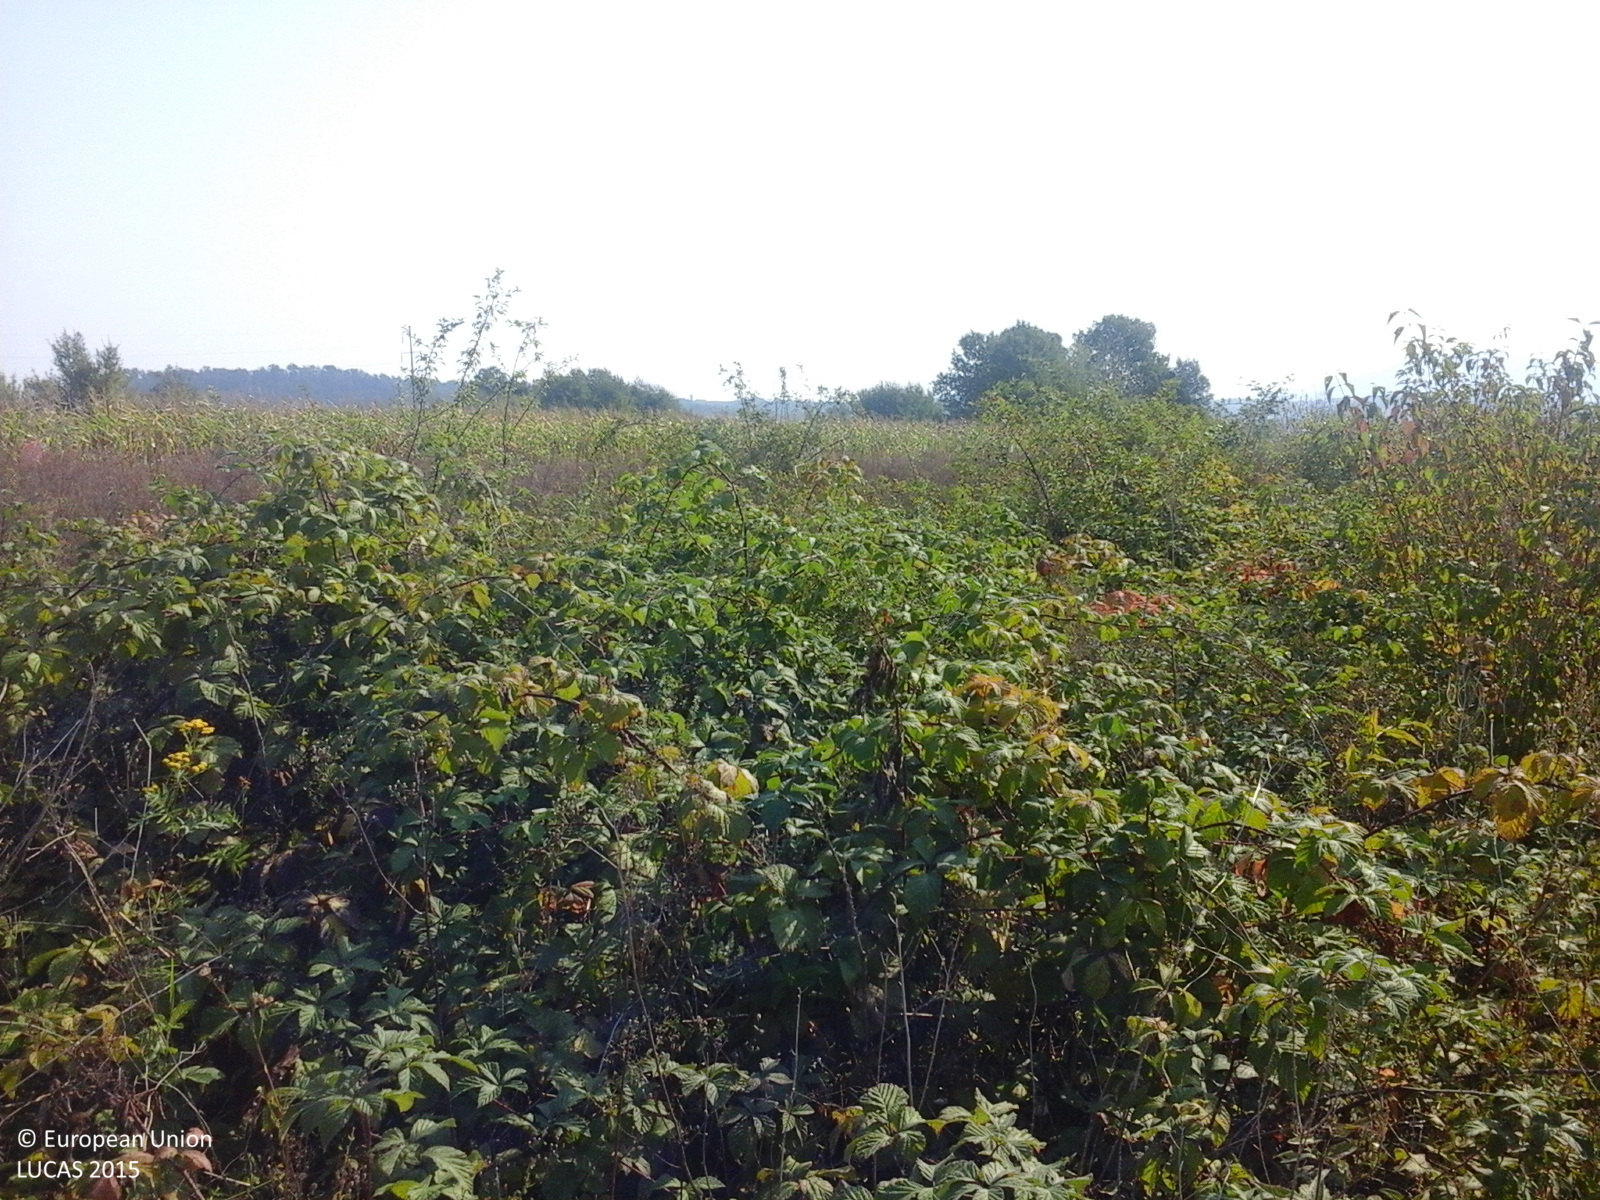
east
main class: Grassland
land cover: Grassland with sparse tree/shrub cover
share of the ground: > 75 %
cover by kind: herbaceous plants 85 %, shrubs 10 %, broadleaved forest trees 5 %
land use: Agriculture (excluding fallow land and kitchen gardens)
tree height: < 5 m
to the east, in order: Grassland with sparse tree/shrub cover; Spontaneously vegetated surfaces; Maize; Grass margins; Tracks; Shrubland with sparse tree cover; Grassland with sparse tree/shrub cover
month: August
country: RO
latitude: 46.3128
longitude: 22.2930
